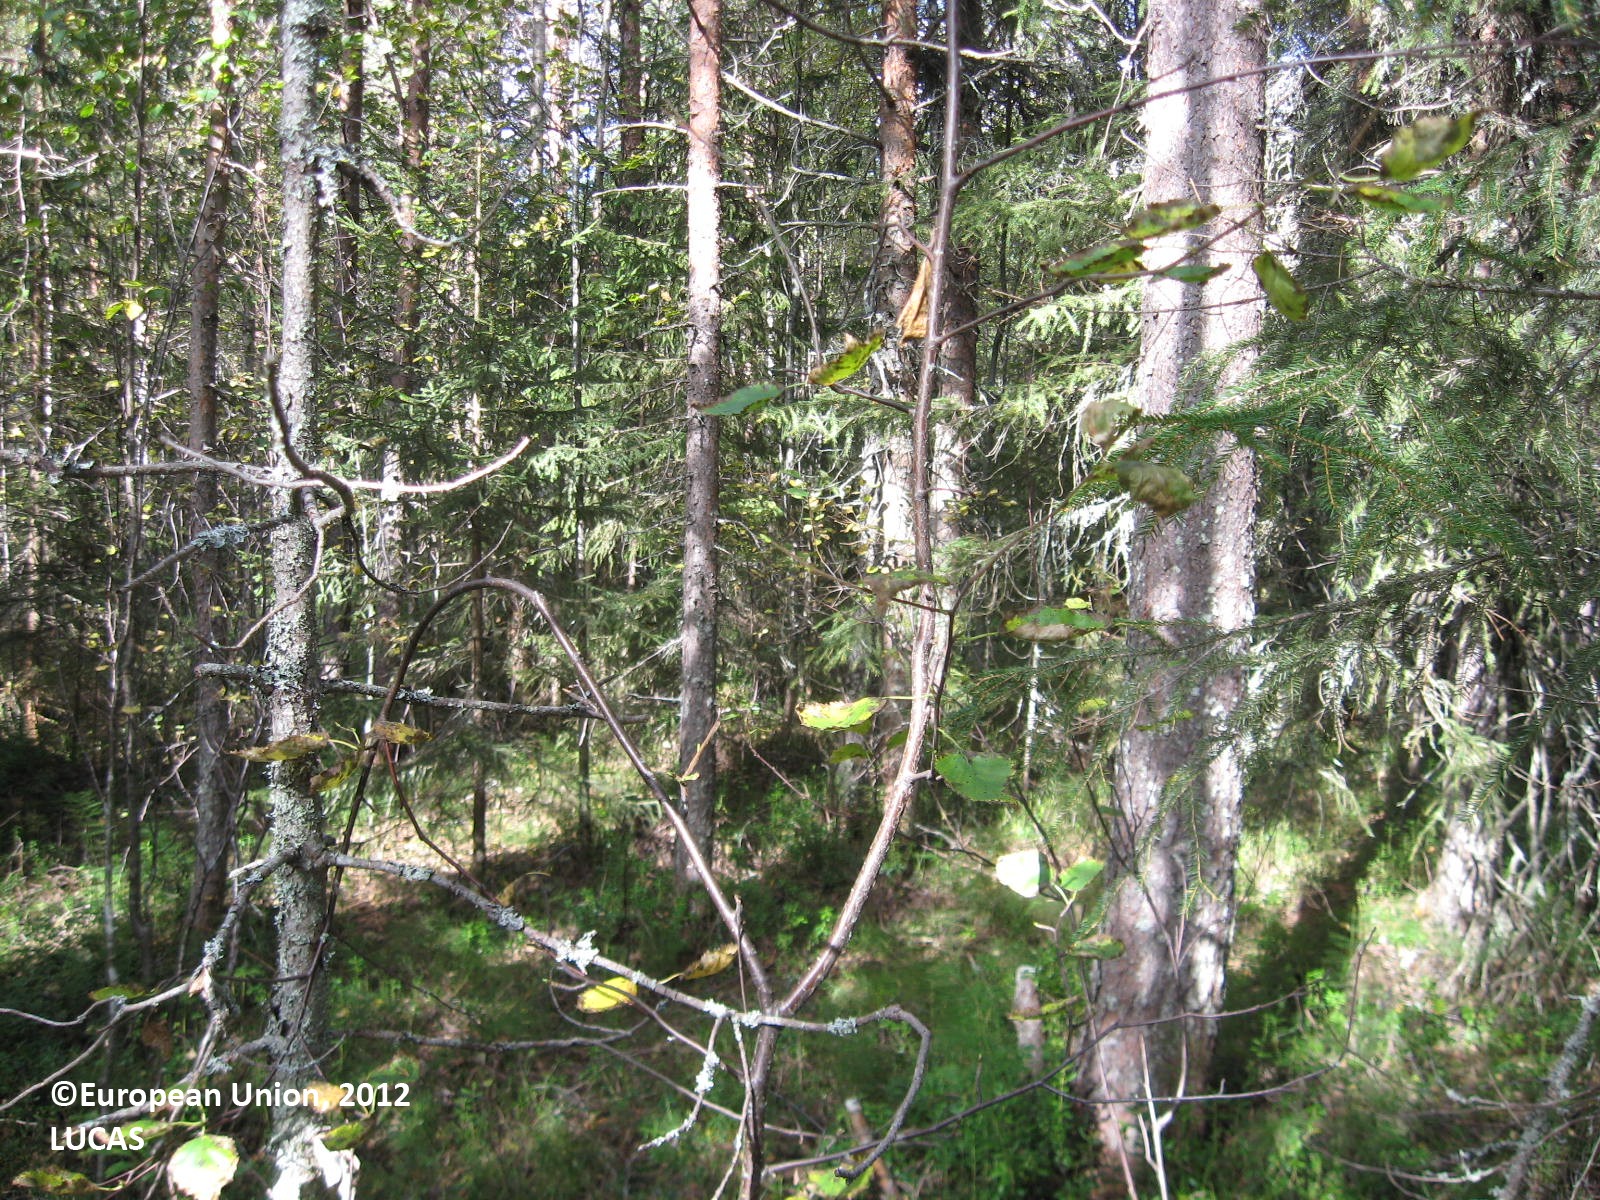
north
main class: Woodland
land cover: Other mixed woodland
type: boreal forest
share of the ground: > 75 %
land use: Forestry
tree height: > 5 m
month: August
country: FI
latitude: 63.9292
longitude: 30.1321
